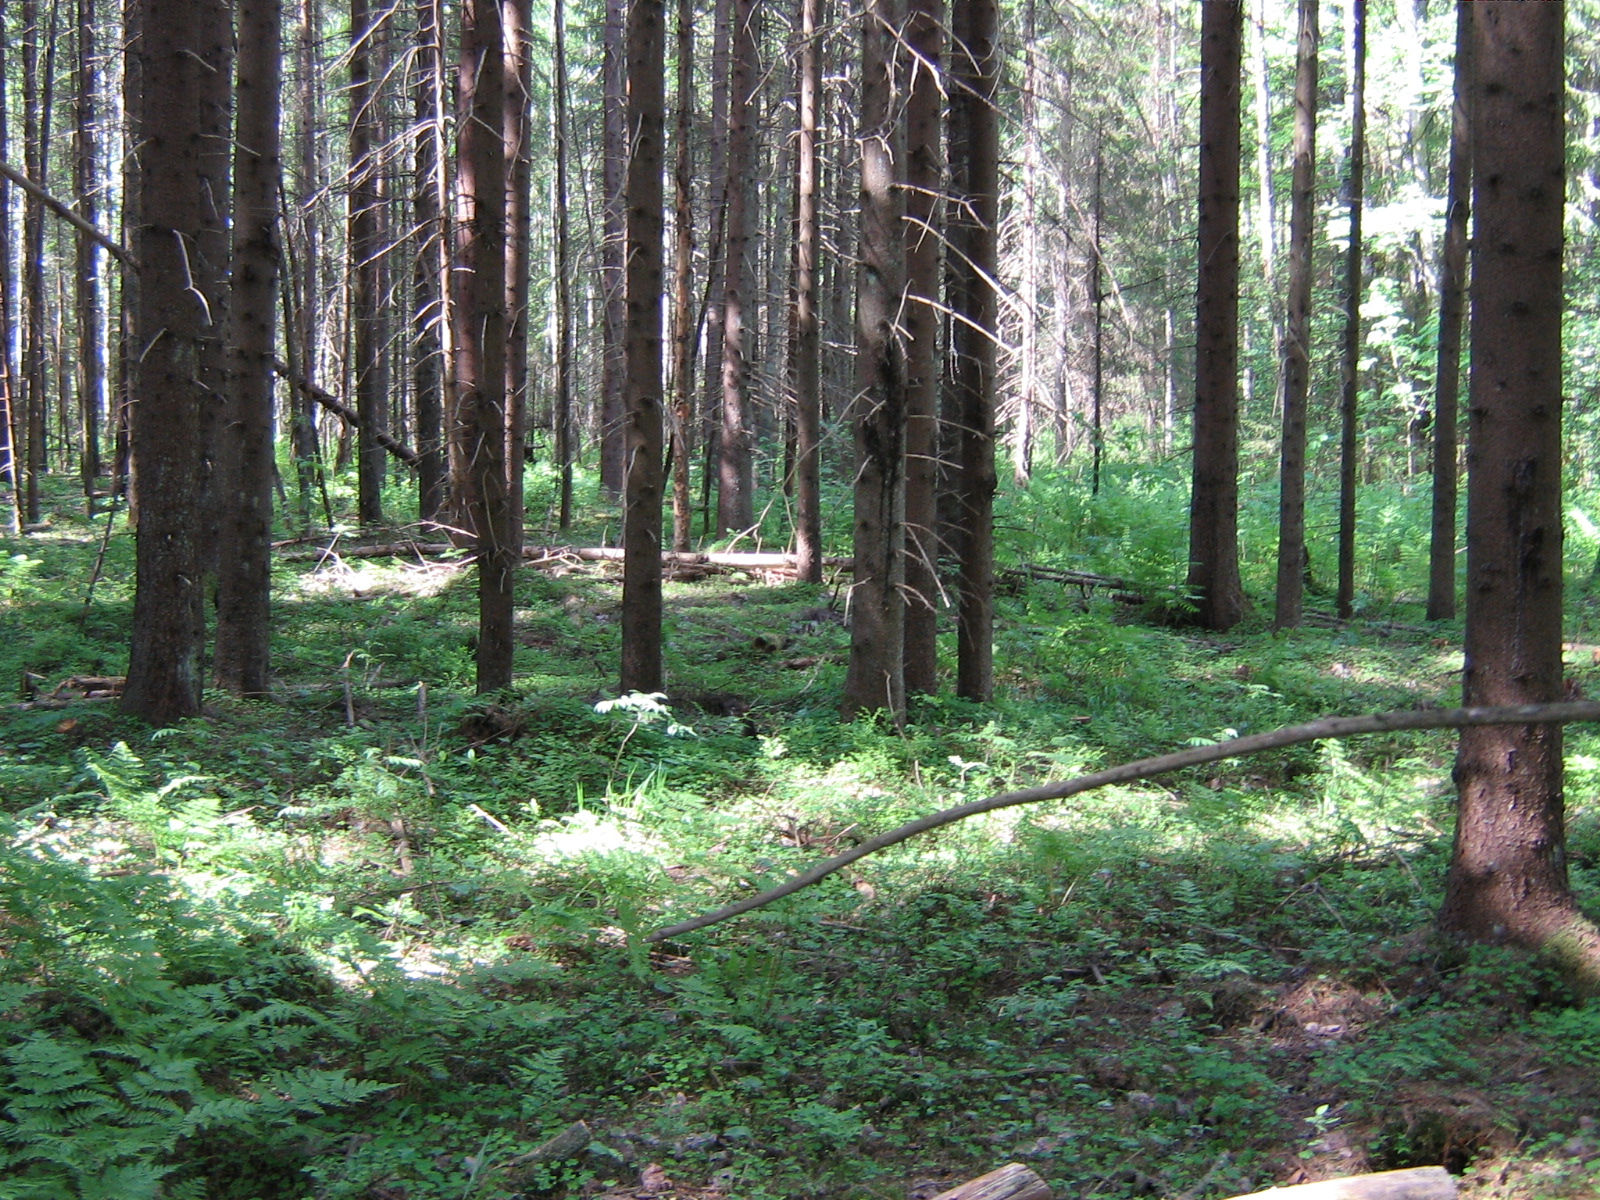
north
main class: Woodland
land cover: Spruce dominated coniferous woodland
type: hemiboreal forest and nemoral coniferous forest and mixed broadleaved-coniferous forest
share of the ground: > 75 %
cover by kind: coniferous forest trees 100 %
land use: Forestry
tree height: > 5 m
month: June
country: LV
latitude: 57.0779
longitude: 25.3063
